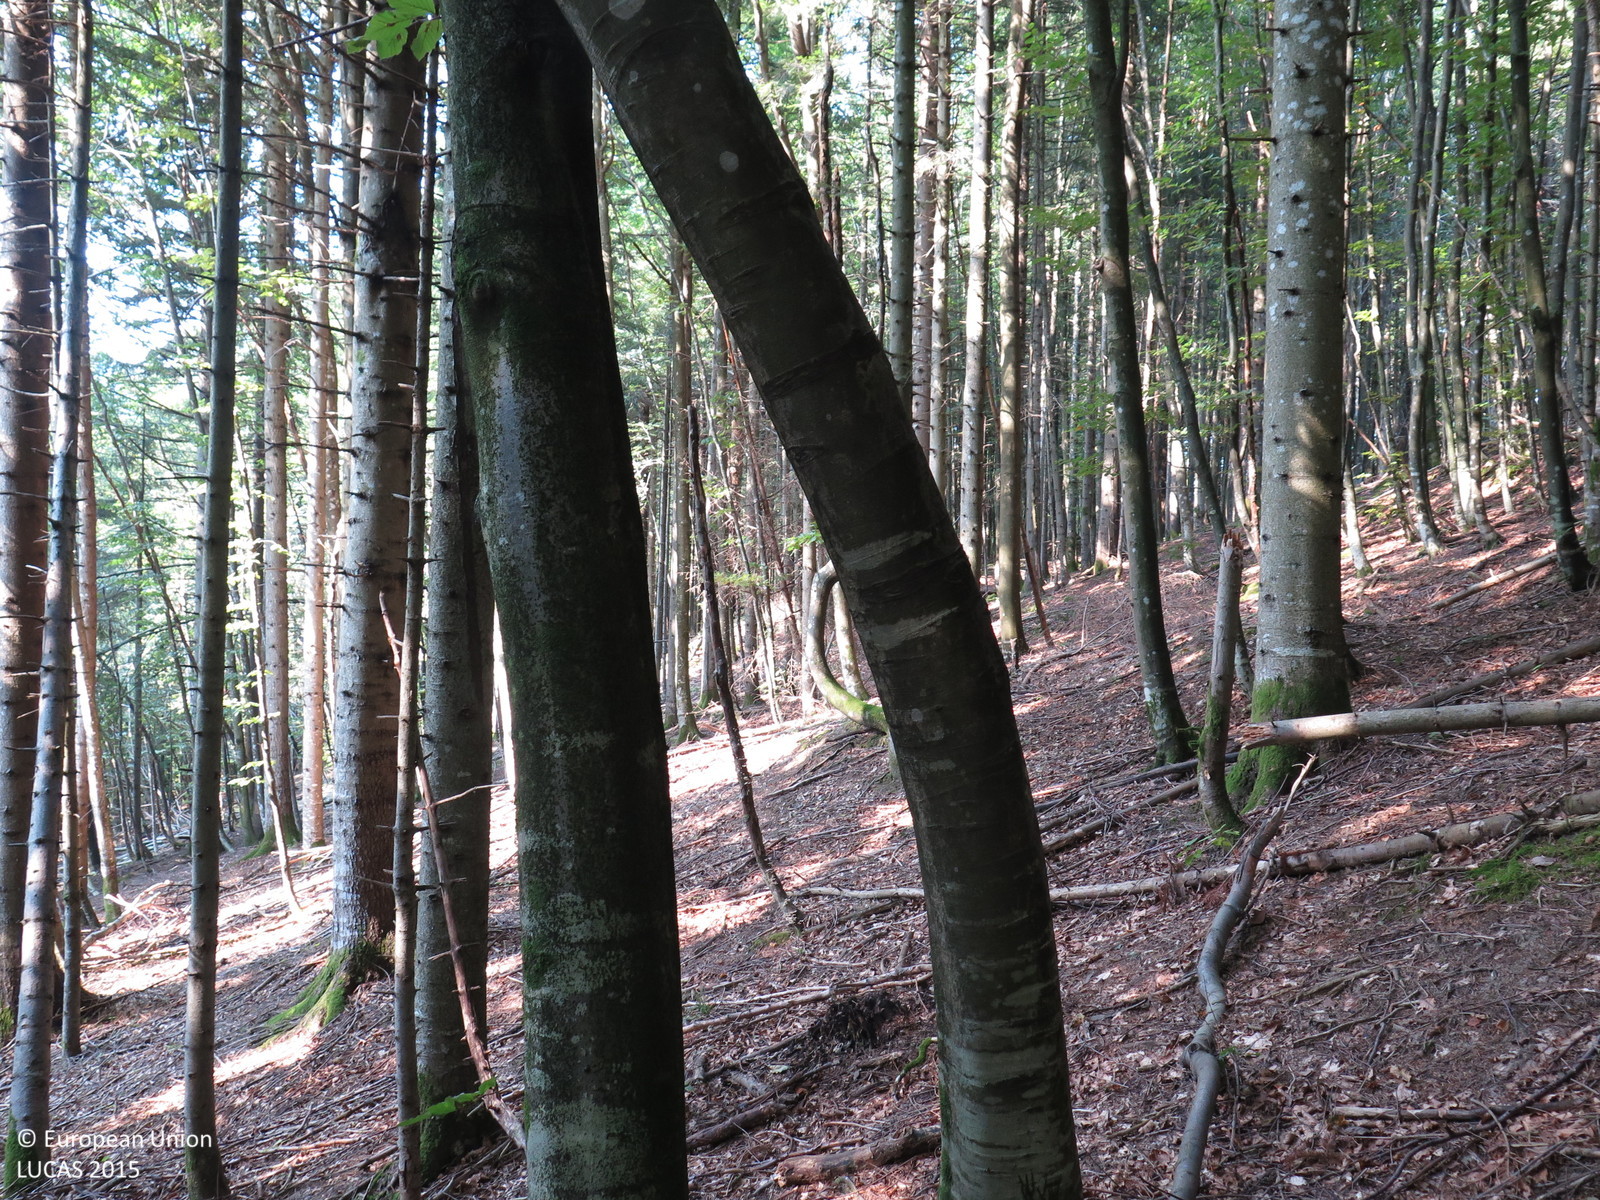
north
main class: Woodland
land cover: Other mixed woodland
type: beech forest
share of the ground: > 75 %
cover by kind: coniferous forest trees 75 %, broadleaved forest trees 25 %
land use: Forestry
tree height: > 5 m
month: August
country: HR
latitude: 45.3469
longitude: 15.0623
